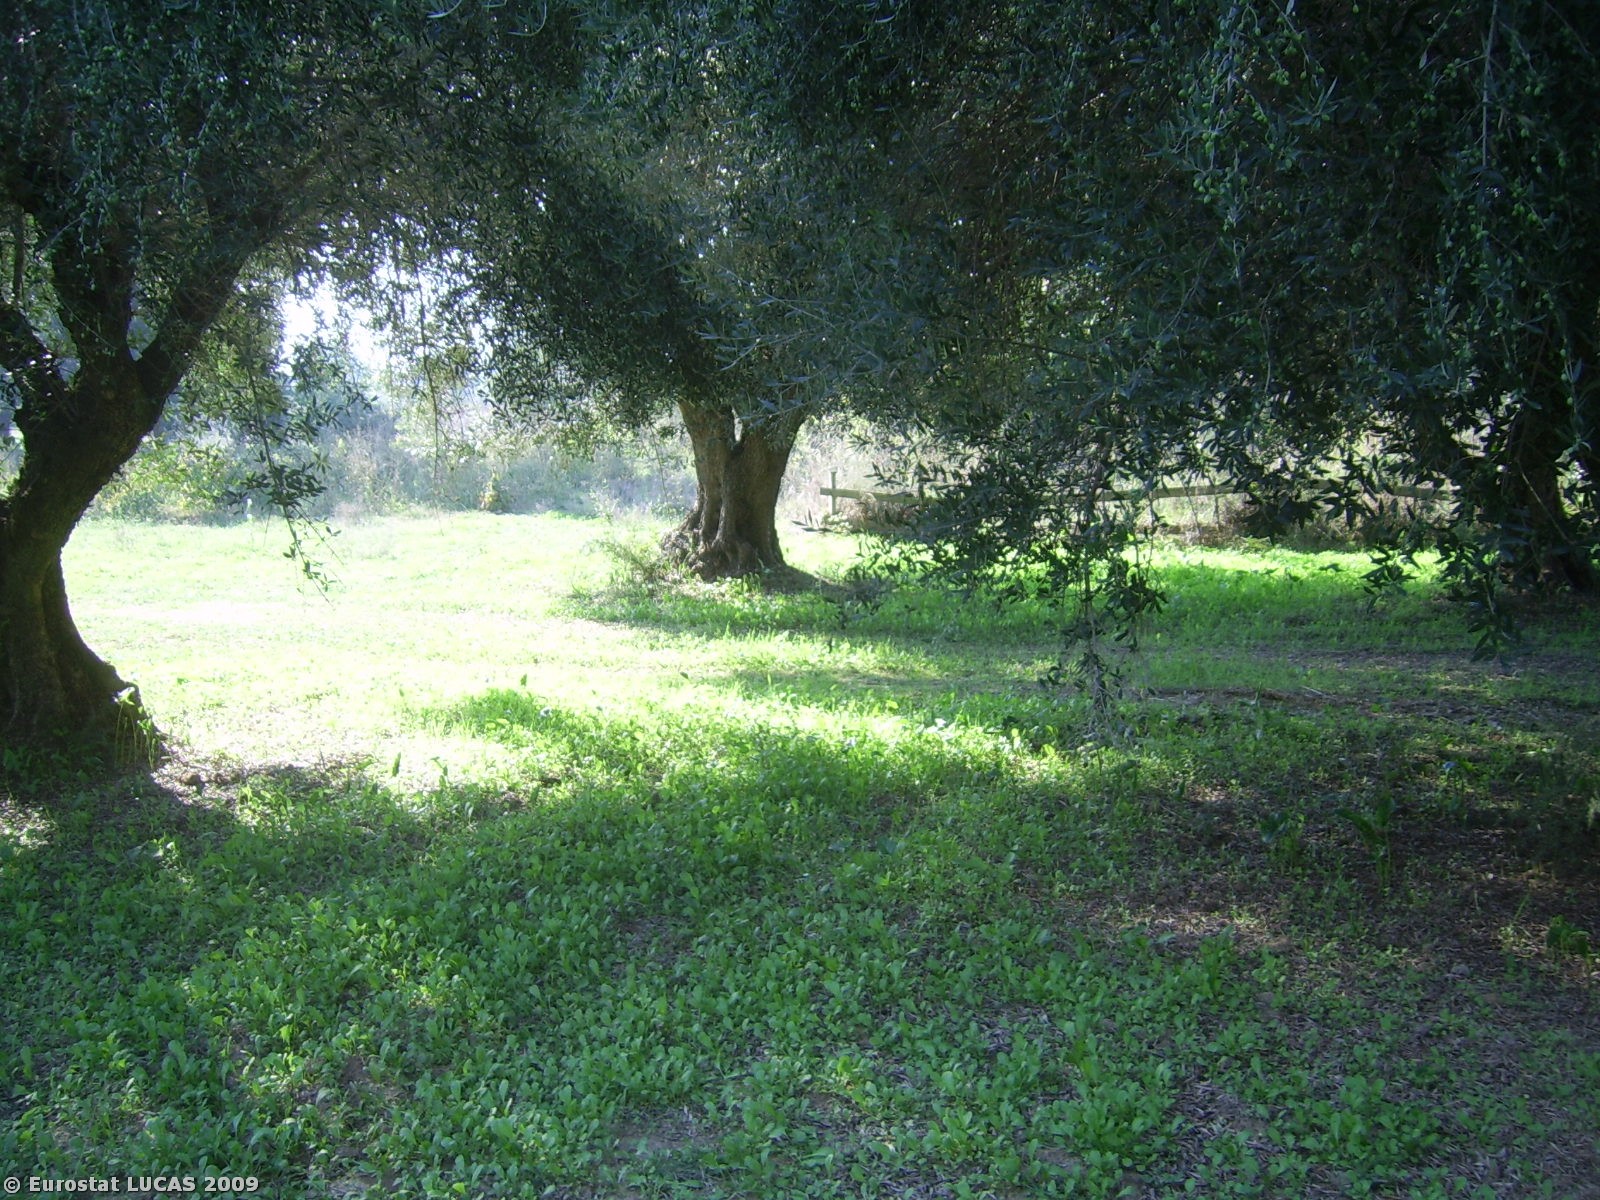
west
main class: Cropland
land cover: Olive groves
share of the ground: 50 - 75 %
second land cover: Grassland with sparse tree/shrub cover
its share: 25 - 50 %
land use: Agriculture (excluding fallow land and kitchen gardens)
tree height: < 5 m
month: October
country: GR
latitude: 37.8153
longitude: 21.3536
